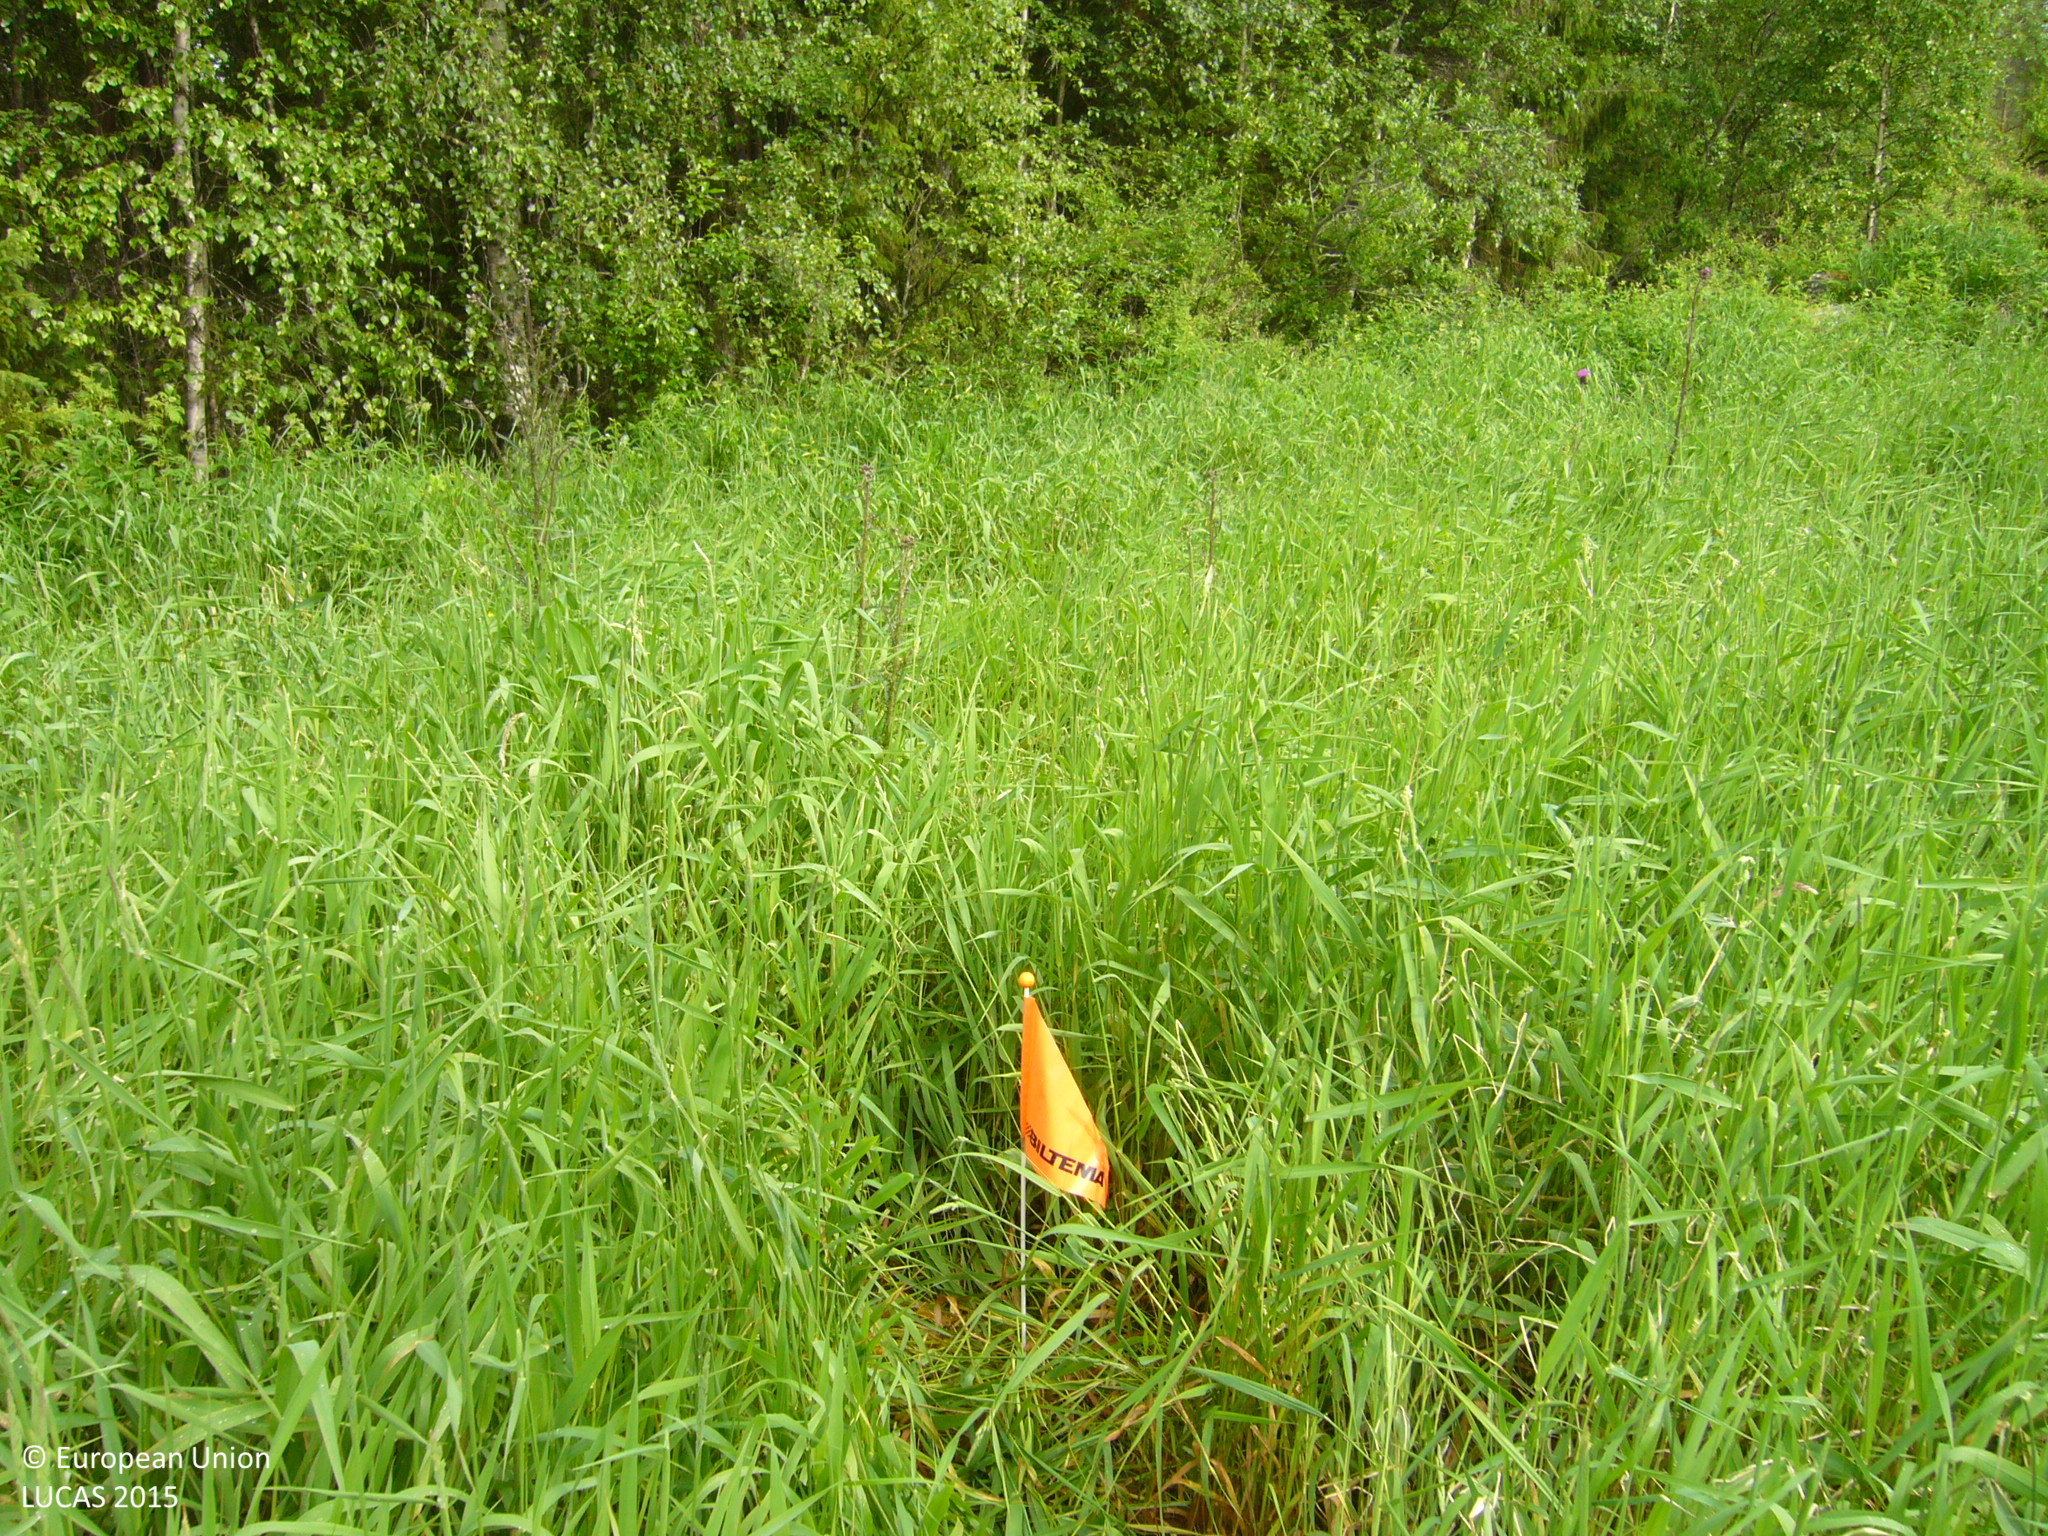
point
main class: Cropland
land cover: Temporary grasslands
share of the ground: > 75 %
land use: Agriculture (excluding fallow land and kitchen gardens)
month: July
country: FI
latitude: 63.5091
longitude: 25.5962
